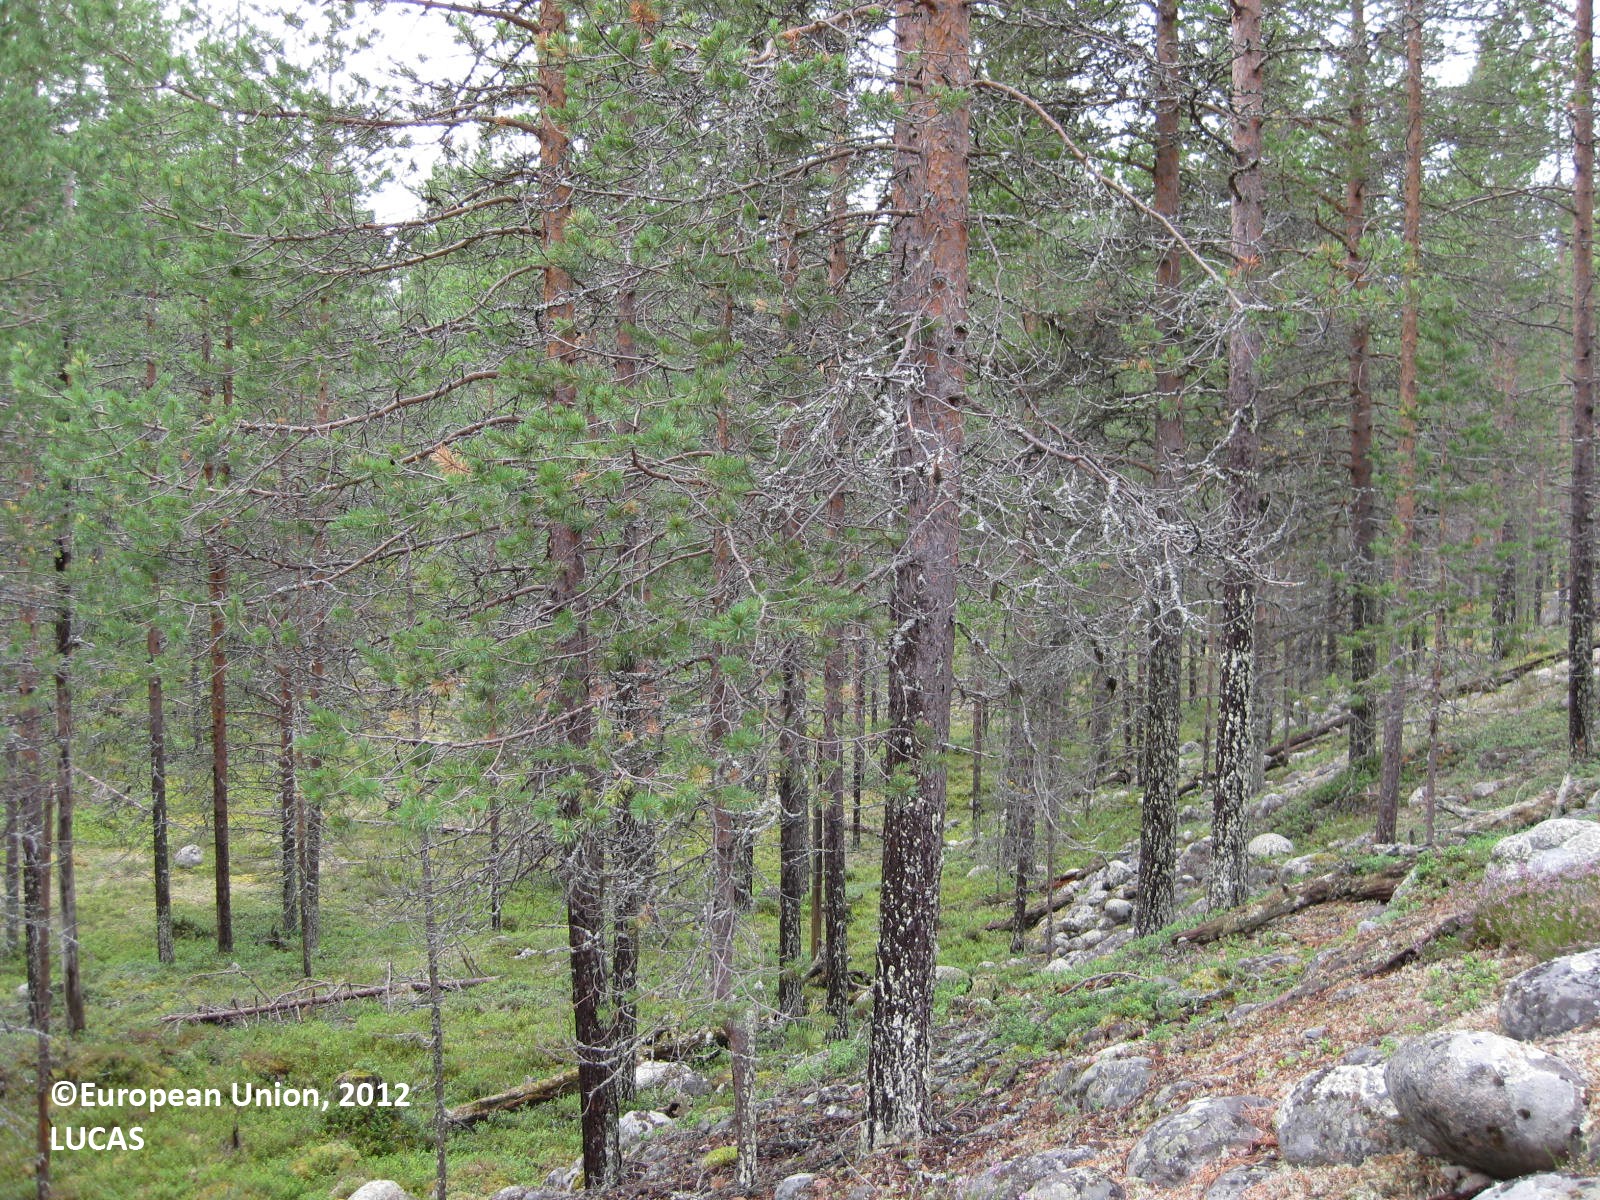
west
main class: Woodland
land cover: Pine dominated coniferous woodland
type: boreal forest
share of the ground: 50 - 75 %
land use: Forestry
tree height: > 5 m
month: August
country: FI
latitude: 66.0073
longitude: 28.1483
